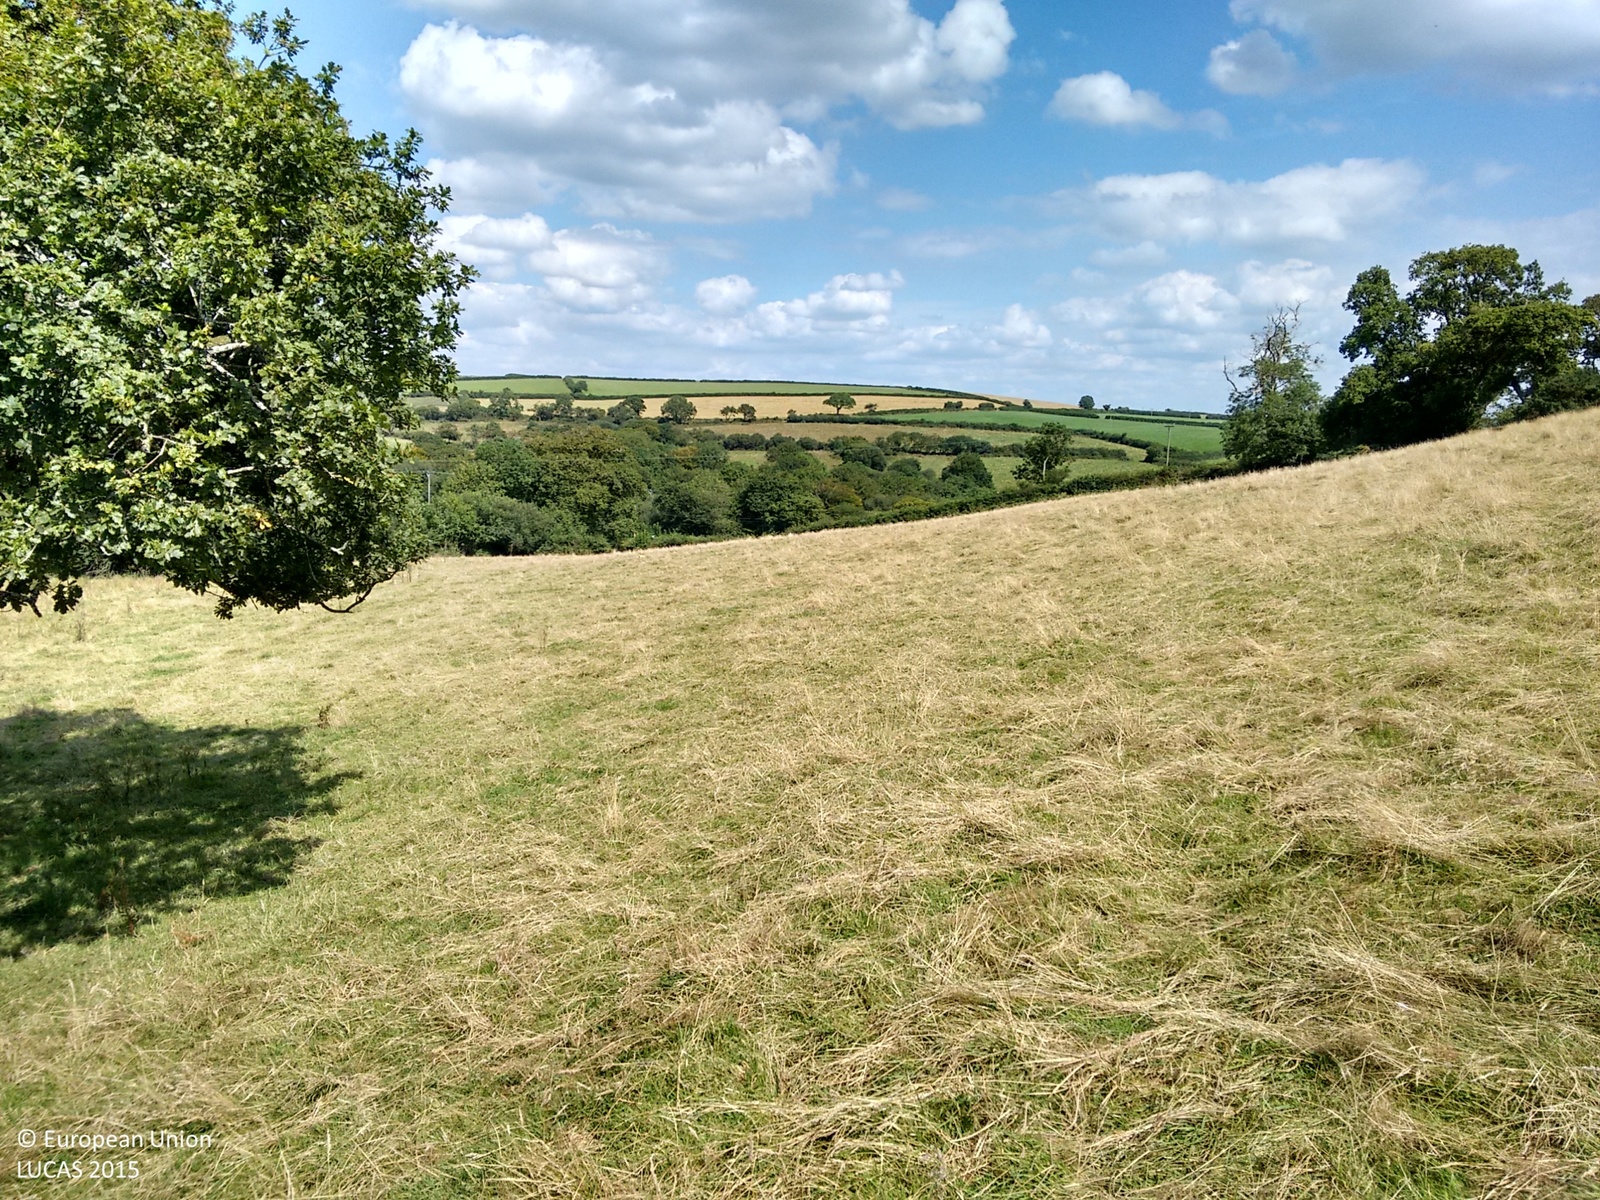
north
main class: Grassland
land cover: Grassland with sparse tree/shrub cover
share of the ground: > 75 %
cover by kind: herbaceous plants 95 %, broadleaved forest trees 5 %
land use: Agriculture (excluding fallow land and kitchen gardens)
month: August
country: GB
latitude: 51.7878
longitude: -4.3826
